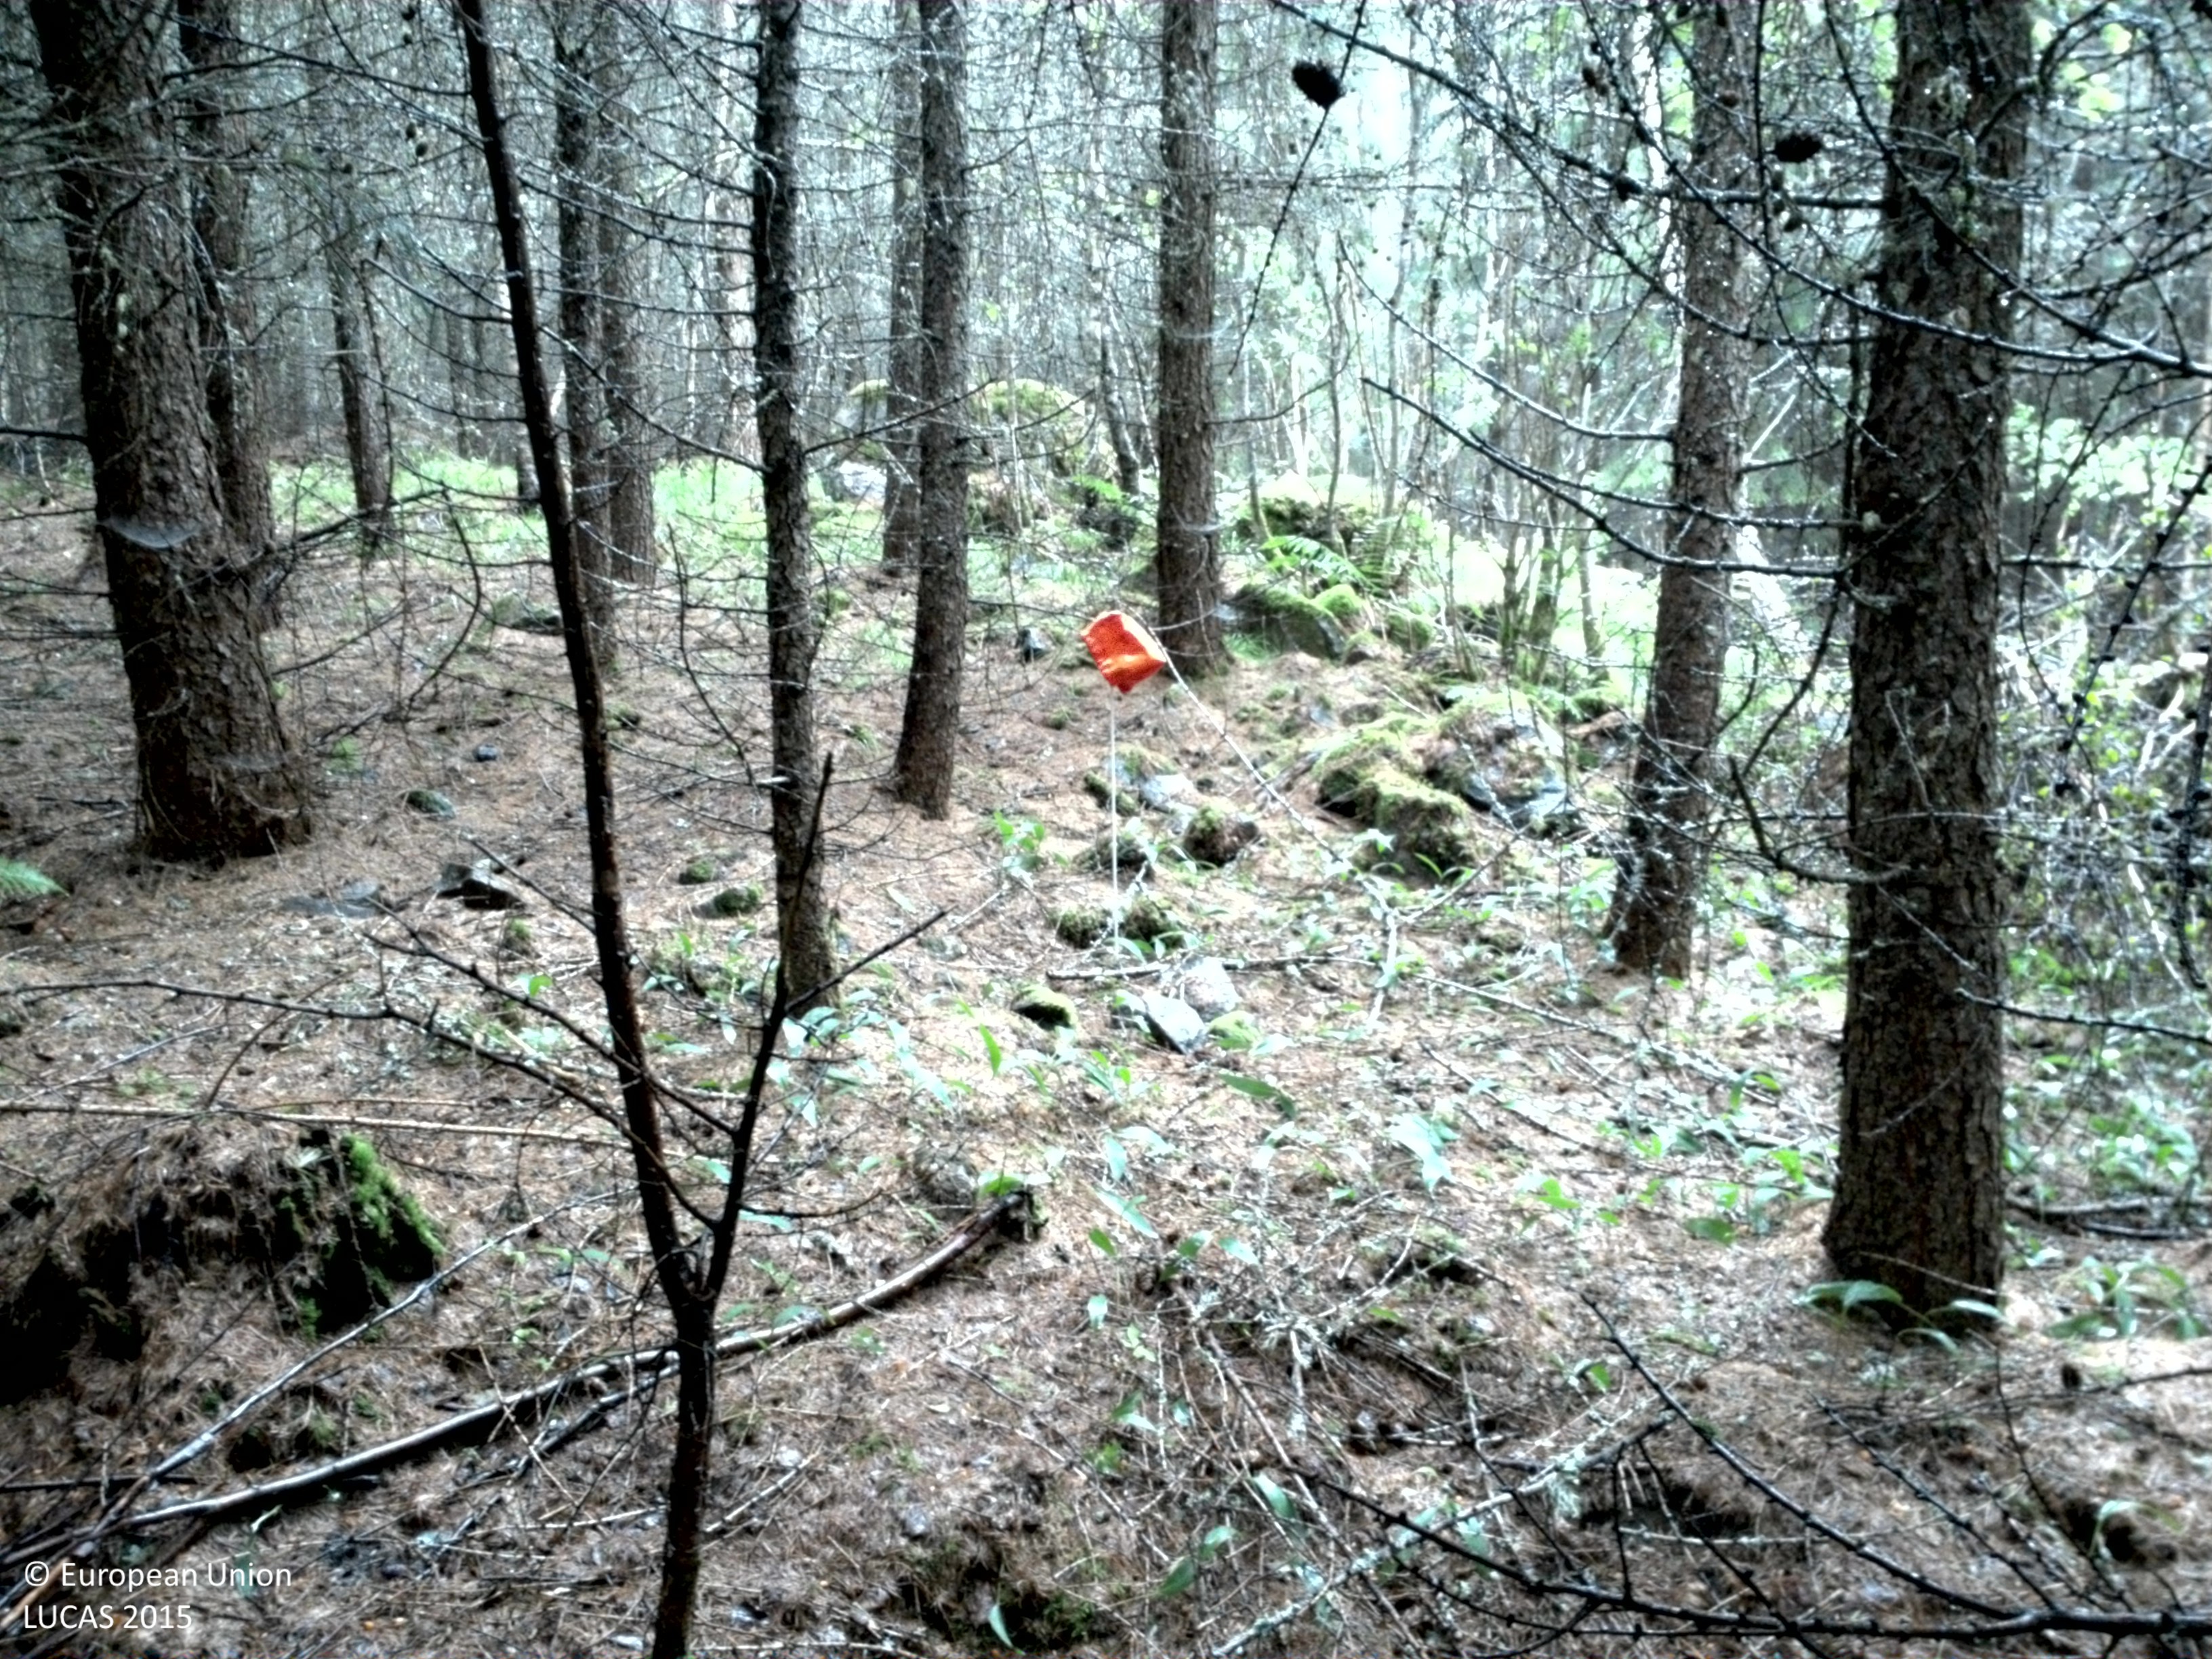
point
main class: Woodland
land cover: Spruce dominated coniferous woodland
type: boreal forest
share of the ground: 50 - 75 %
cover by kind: coniferous forest trees 70 %, consolidated bare surface 20 %, herbaceous plants 10 %
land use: Forestry
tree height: > 5 m
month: June
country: SE
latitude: 58.7215
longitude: 15.4675
